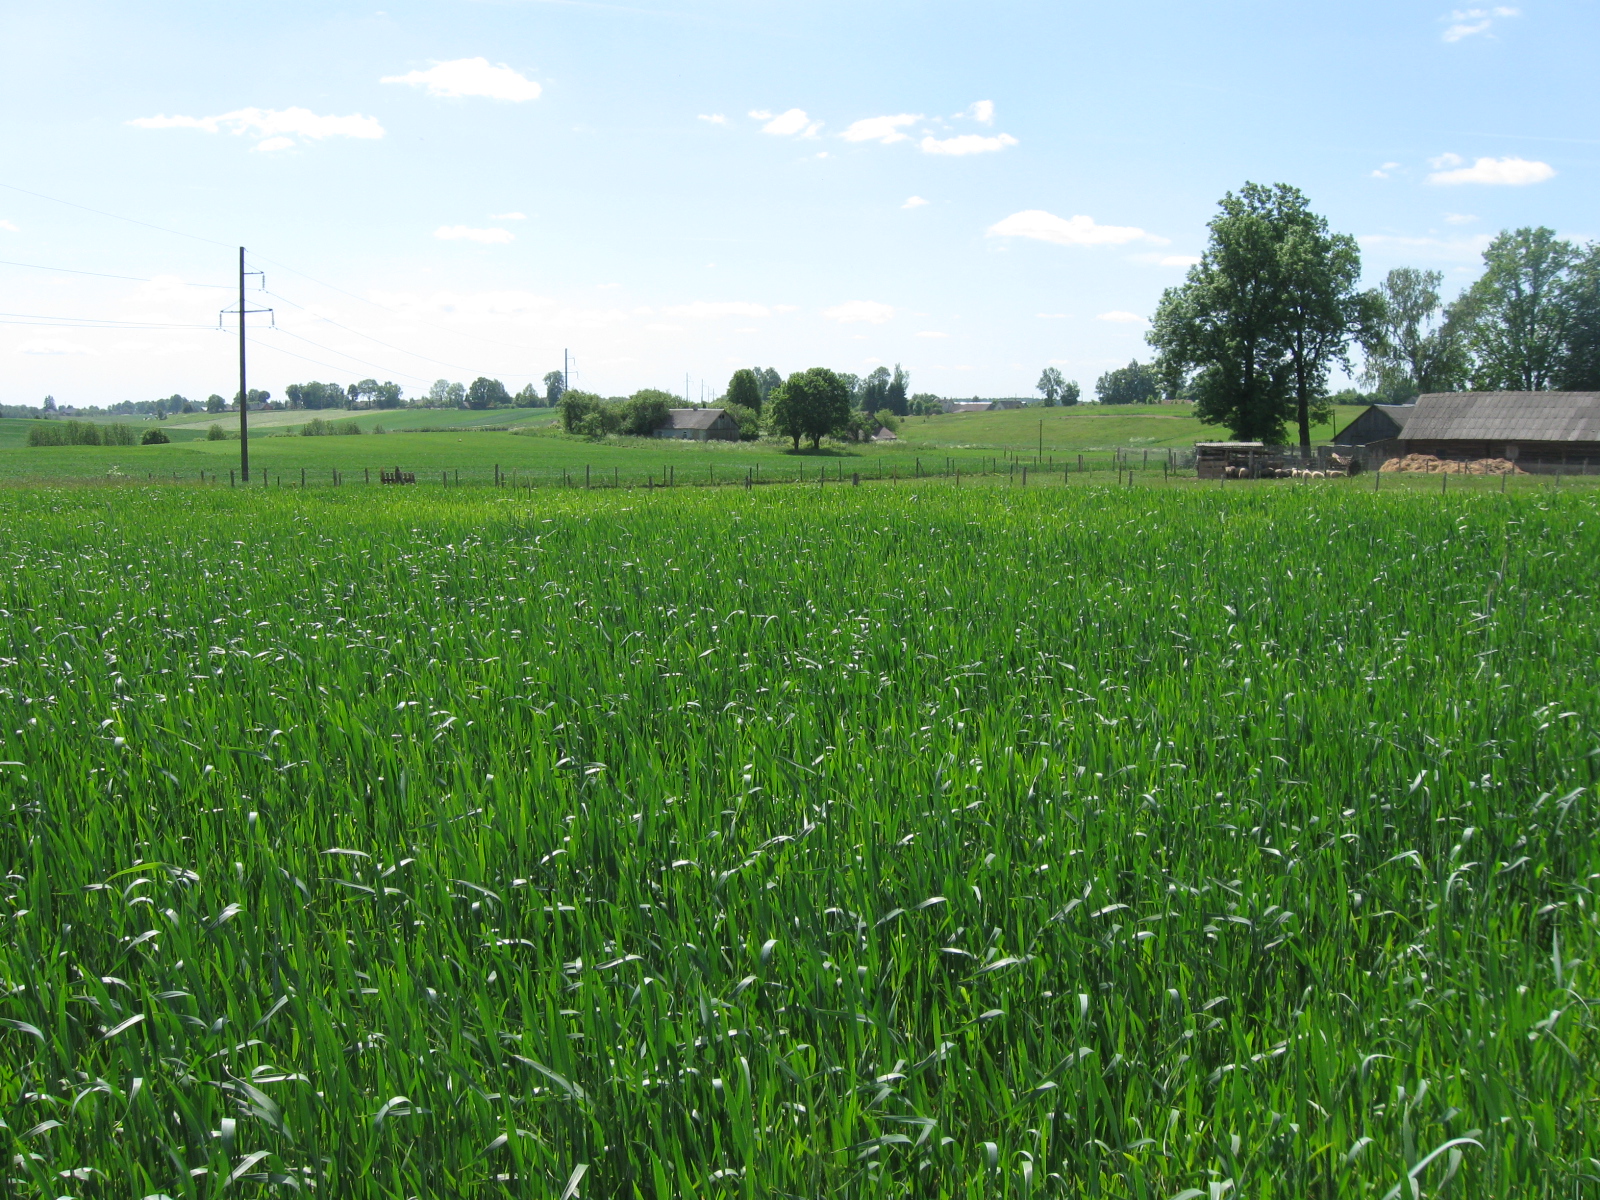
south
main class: Cropland
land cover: Common wheat
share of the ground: > 75 %
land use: Agriculture (excluding fallow land and kitchen gardens)
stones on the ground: < 10 %
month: June
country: LT
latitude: 54.5916
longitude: 23.8469
